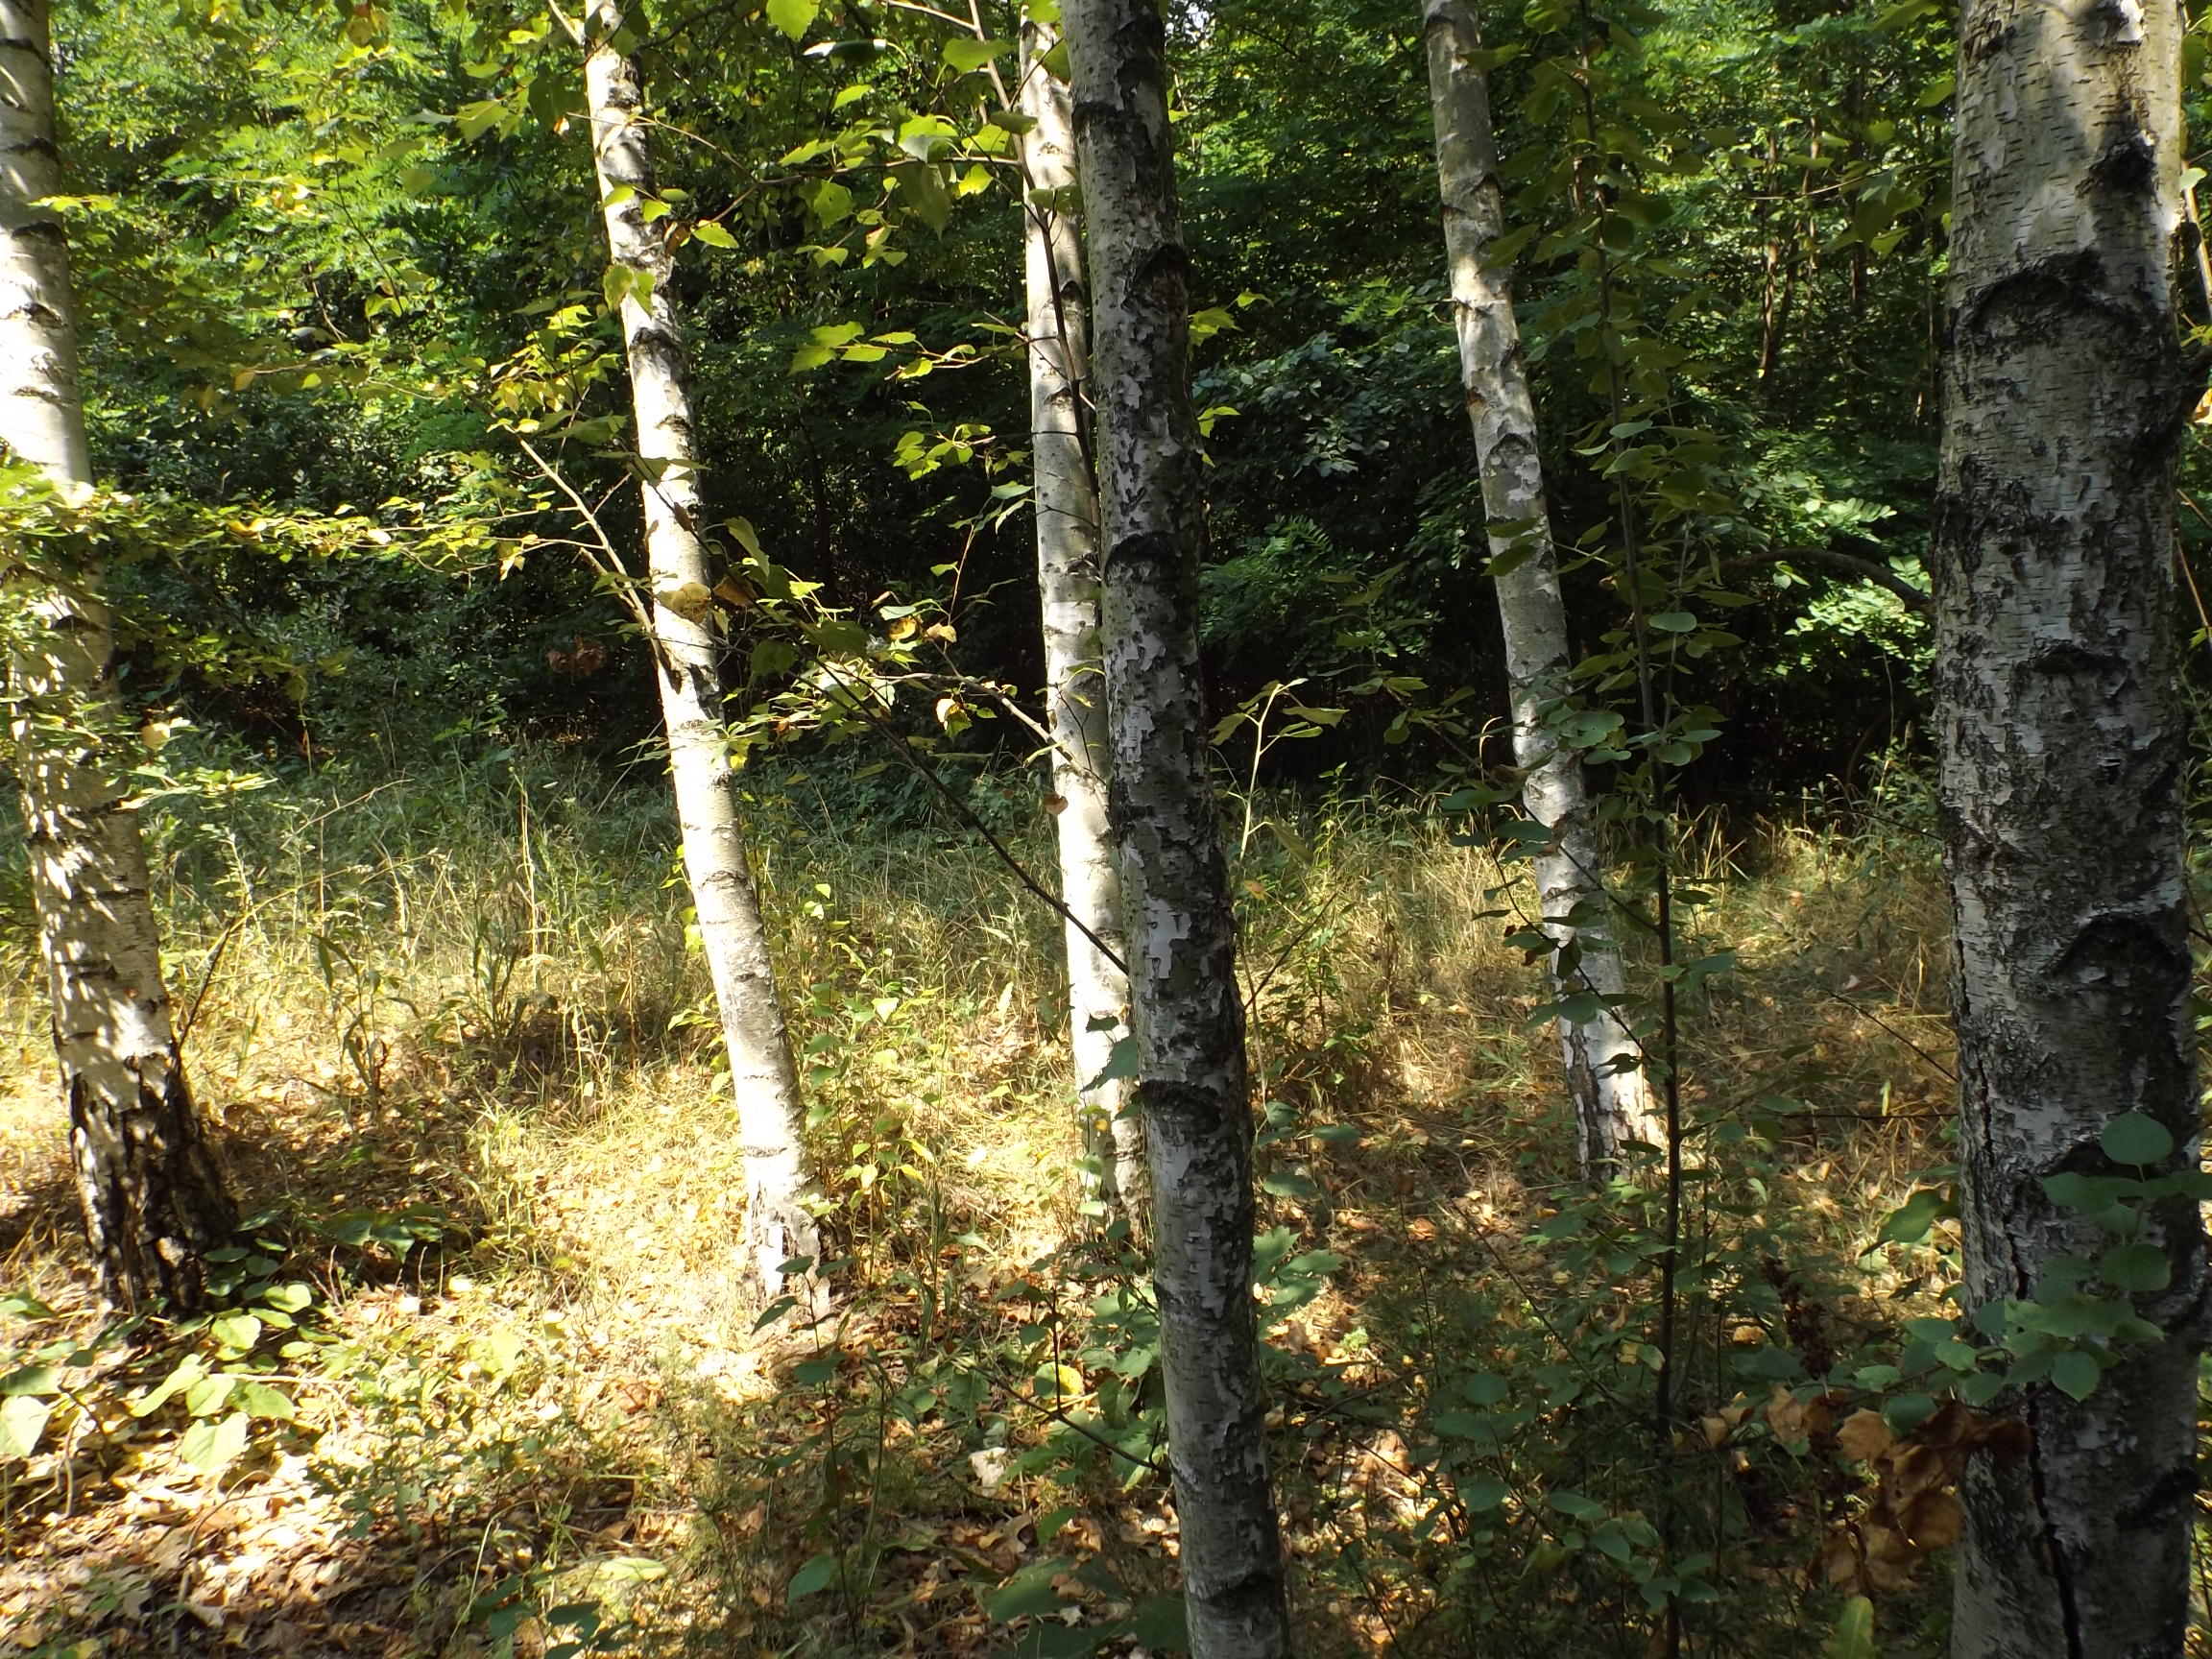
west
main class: Woodland
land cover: Broadleaved woodland
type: non-riverine alder, birch or aspen forest
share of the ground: > 75 %
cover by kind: broadleaved forest trees 95 %, herbaceous plants 5 %
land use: Forestry
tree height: > 5 m
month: July
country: BG
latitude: 43.4413
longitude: 27.5912
